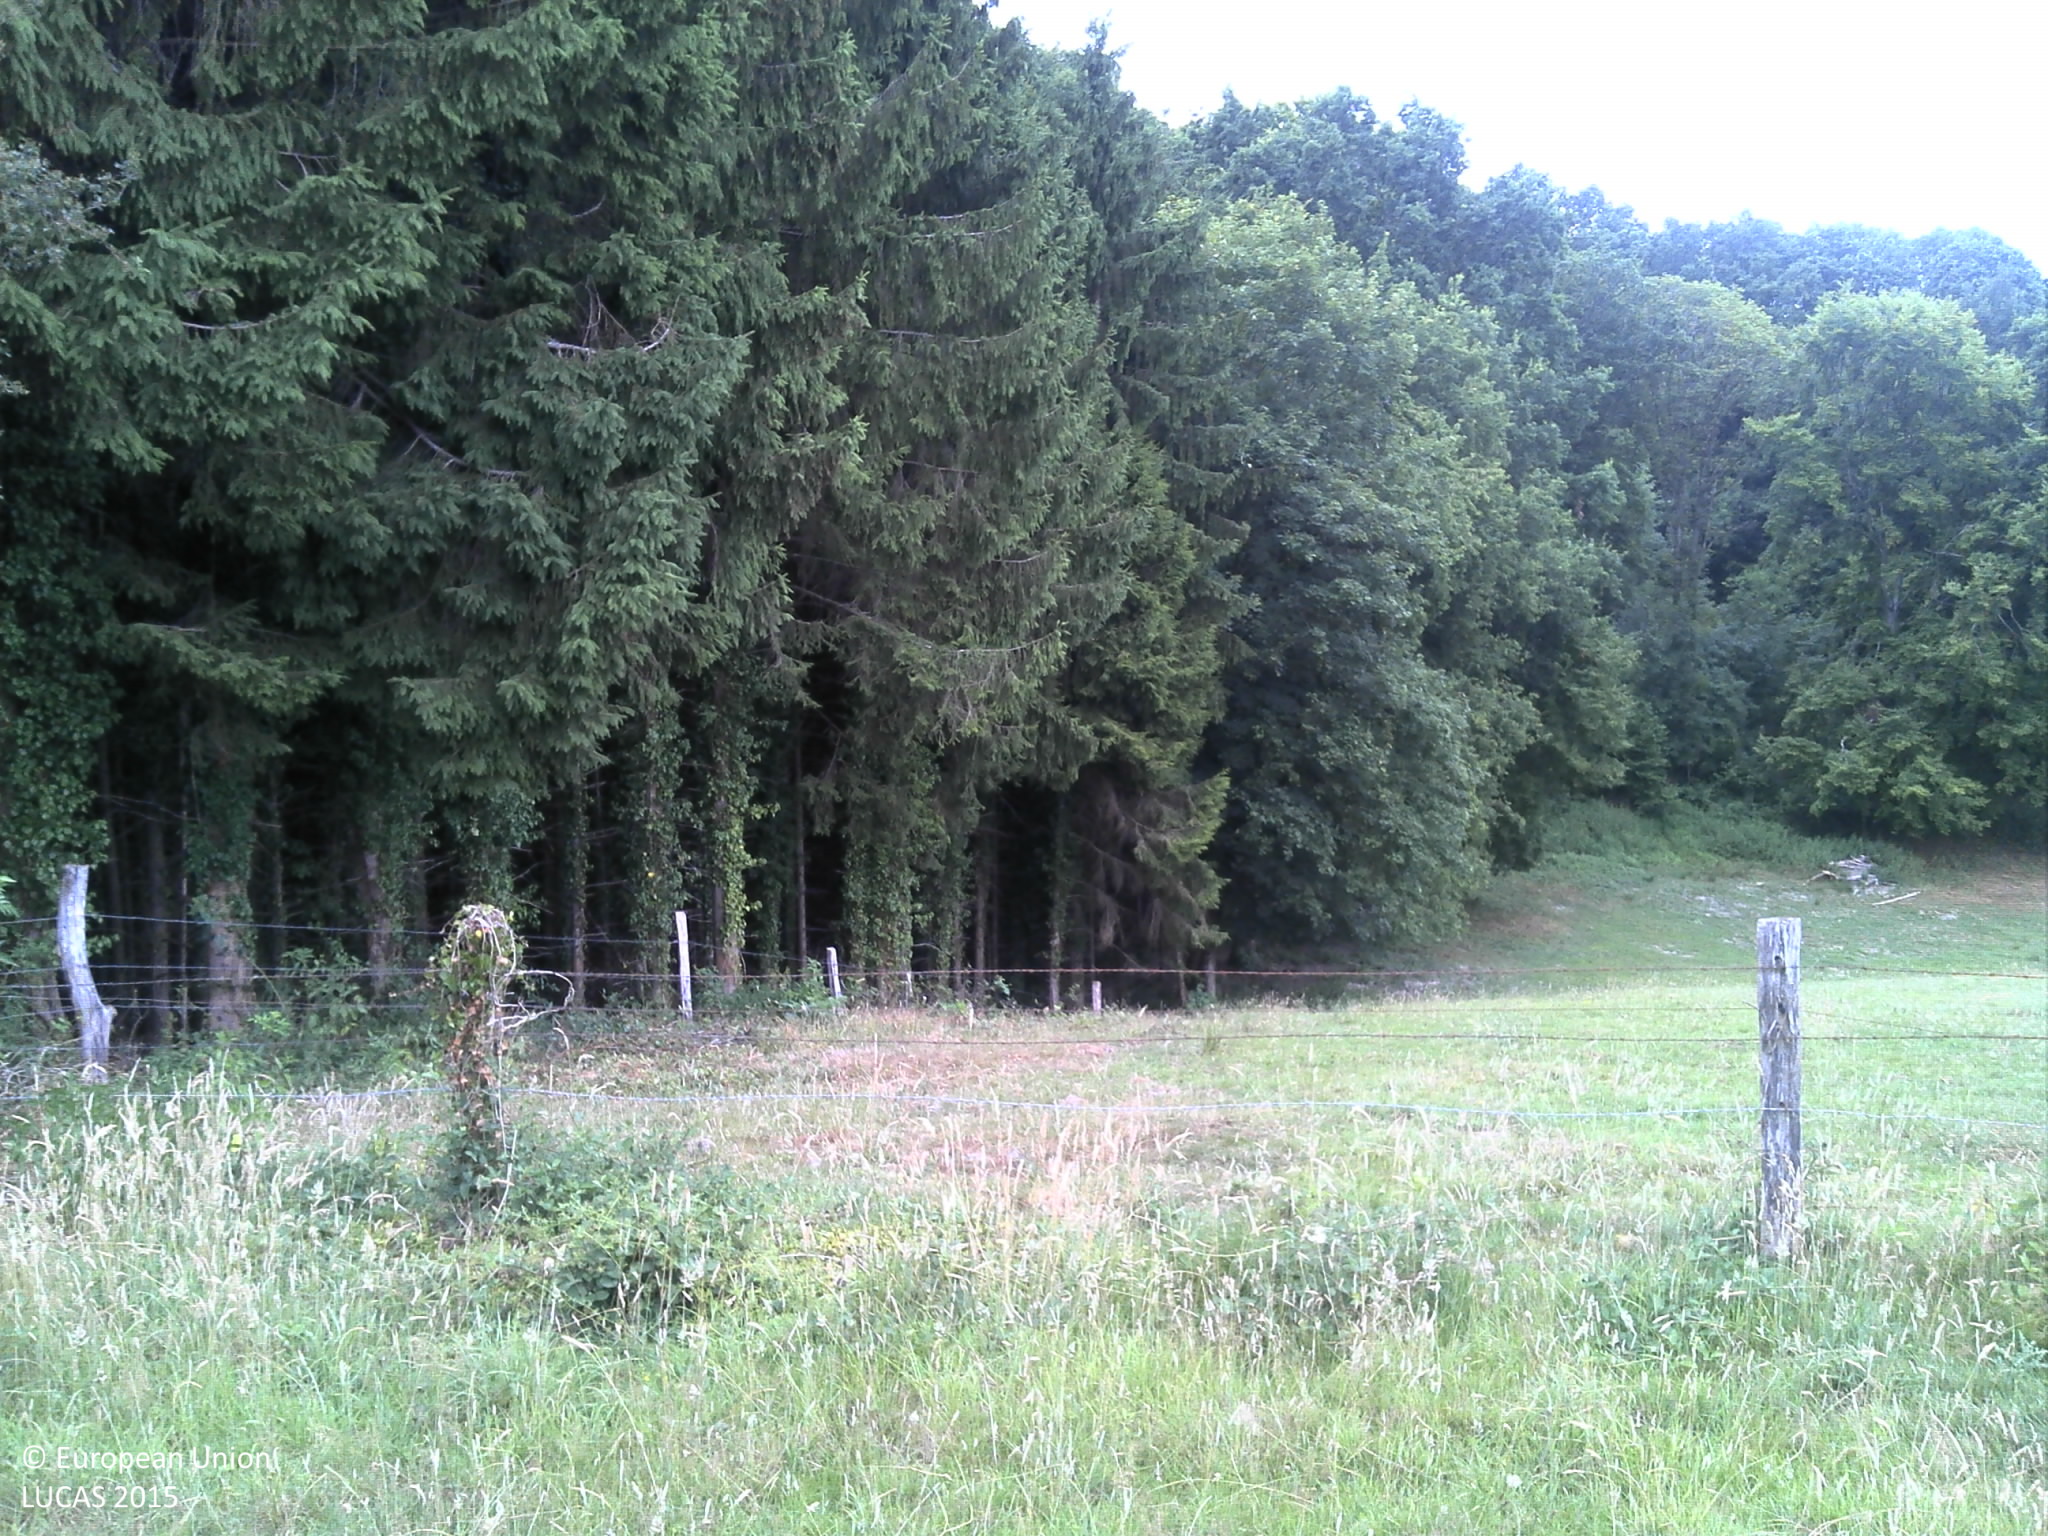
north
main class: Grassland
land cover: Grassland without tree/shrub cover
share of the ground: > 75 %
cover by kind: herbaceous plants 100 %
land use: Agriculture (excluding fallow land and kitchen gardens)
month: July
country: FR
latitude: 49.3964
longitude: 4.7473
